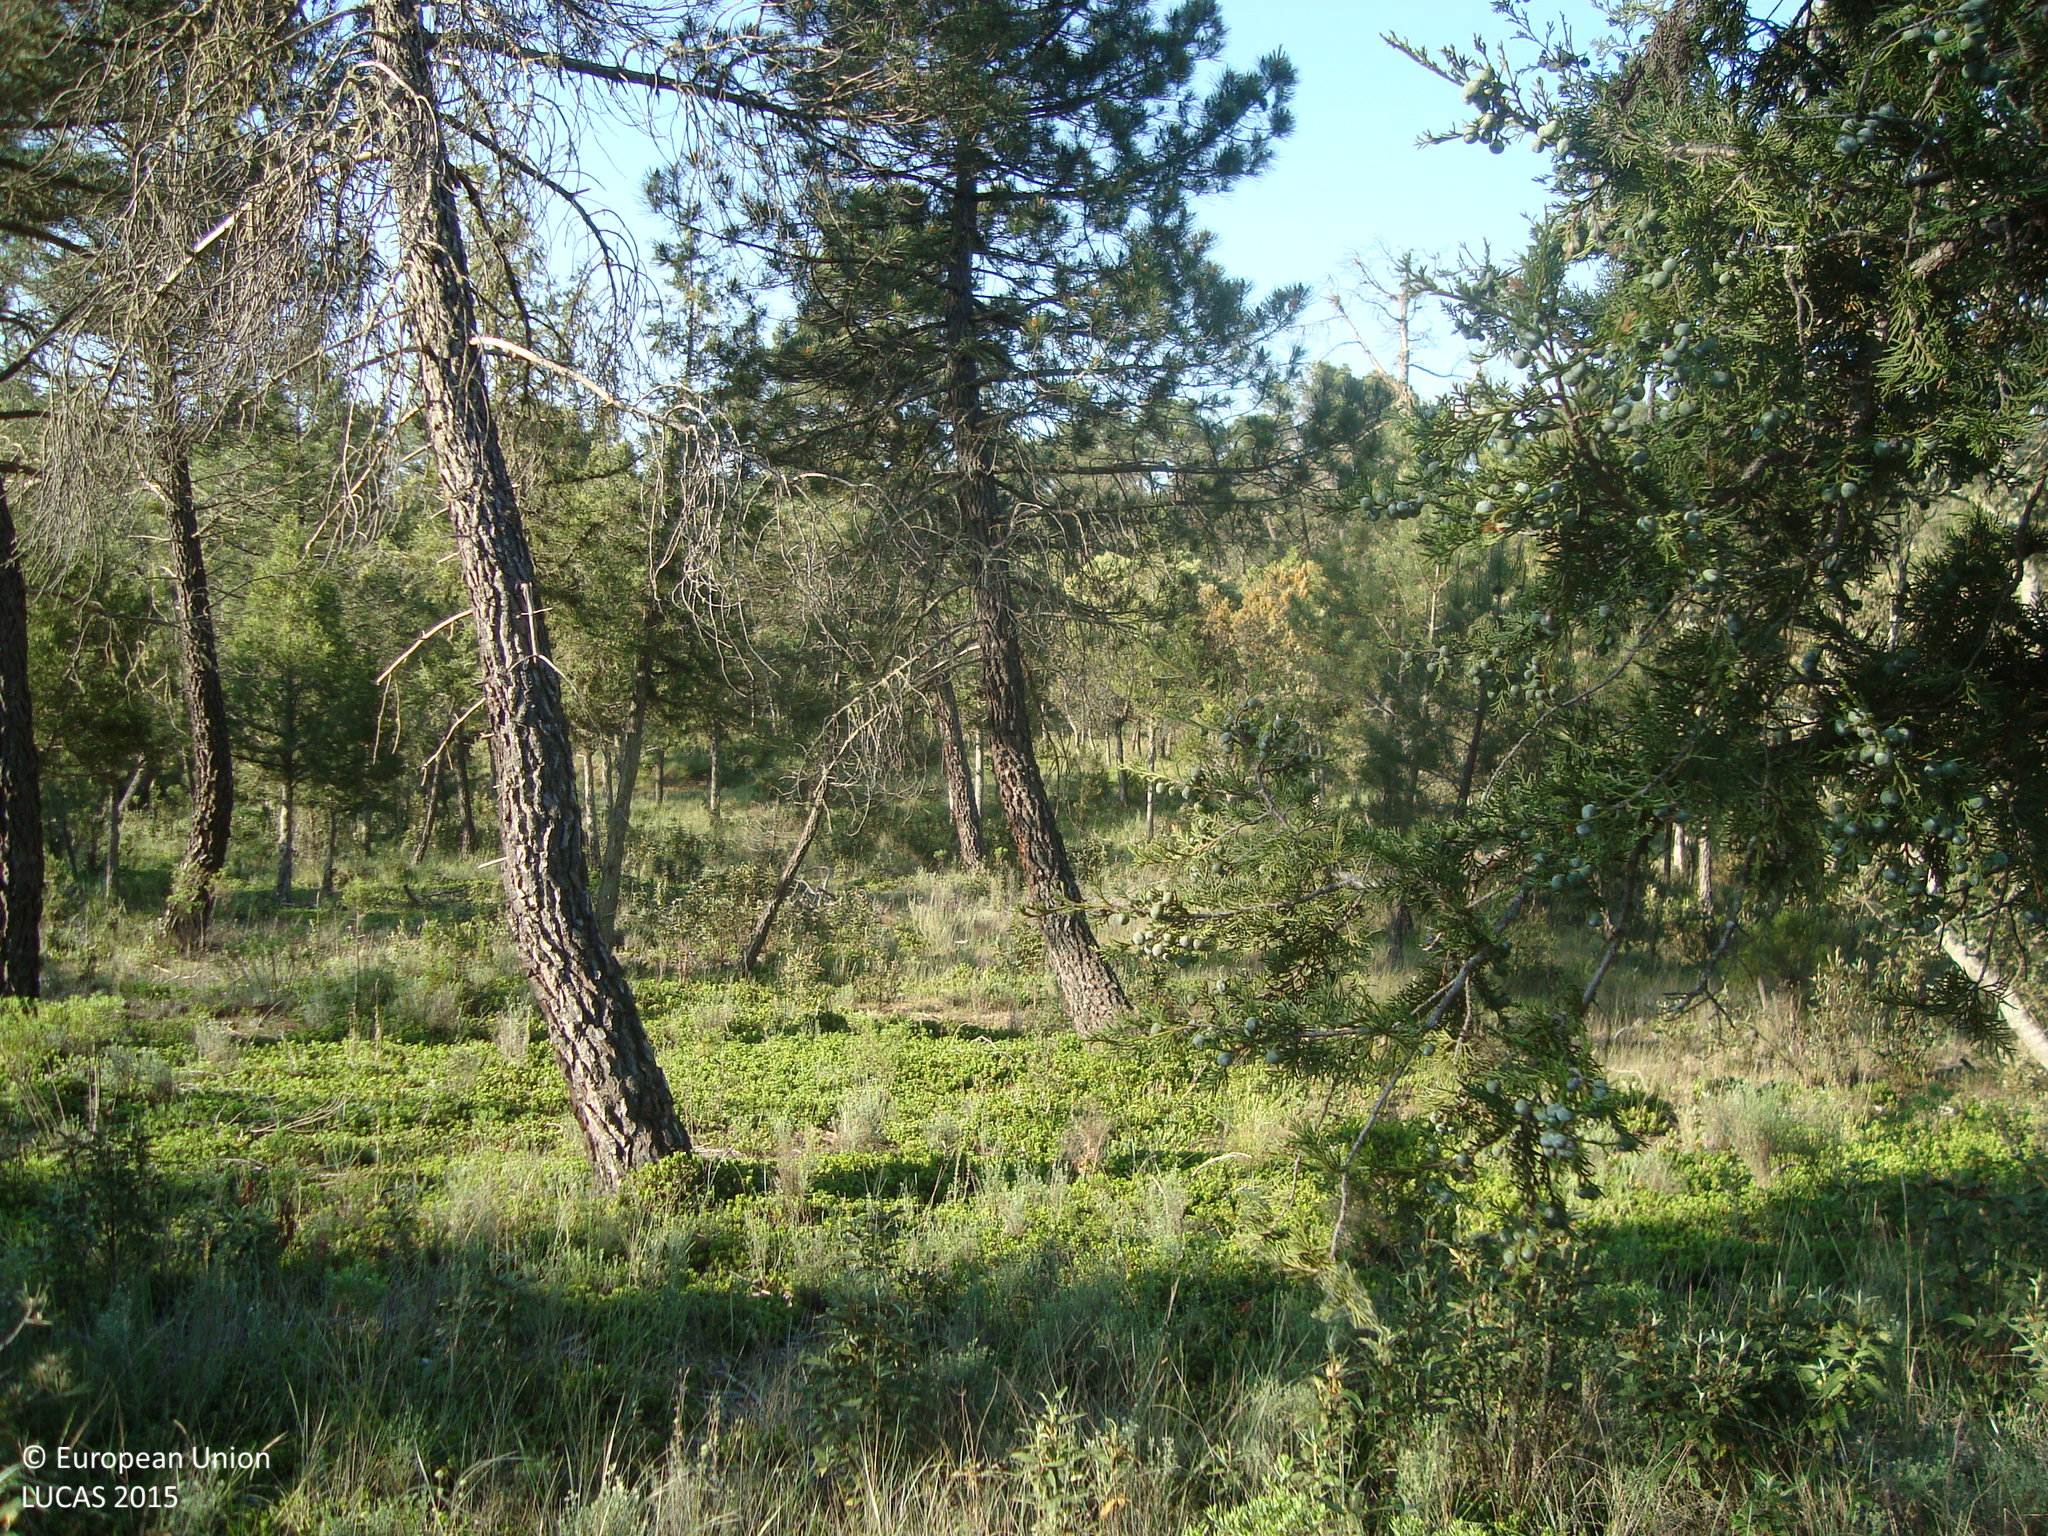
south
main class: Woodland
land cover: Pine dominated mixed woodland
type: coniferous forest of the mediterranean region
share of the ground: 50 - 75 %
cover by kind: broadleaved forest trees 40 %, coniferous forest trees 30 %, shrubs 20 %, herbaceous plants 5 %, unconsolidated bare surface 5 %
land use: Forestry
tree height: > 5 m
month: June
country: ES
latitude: 41.7672
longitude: -3.6095
